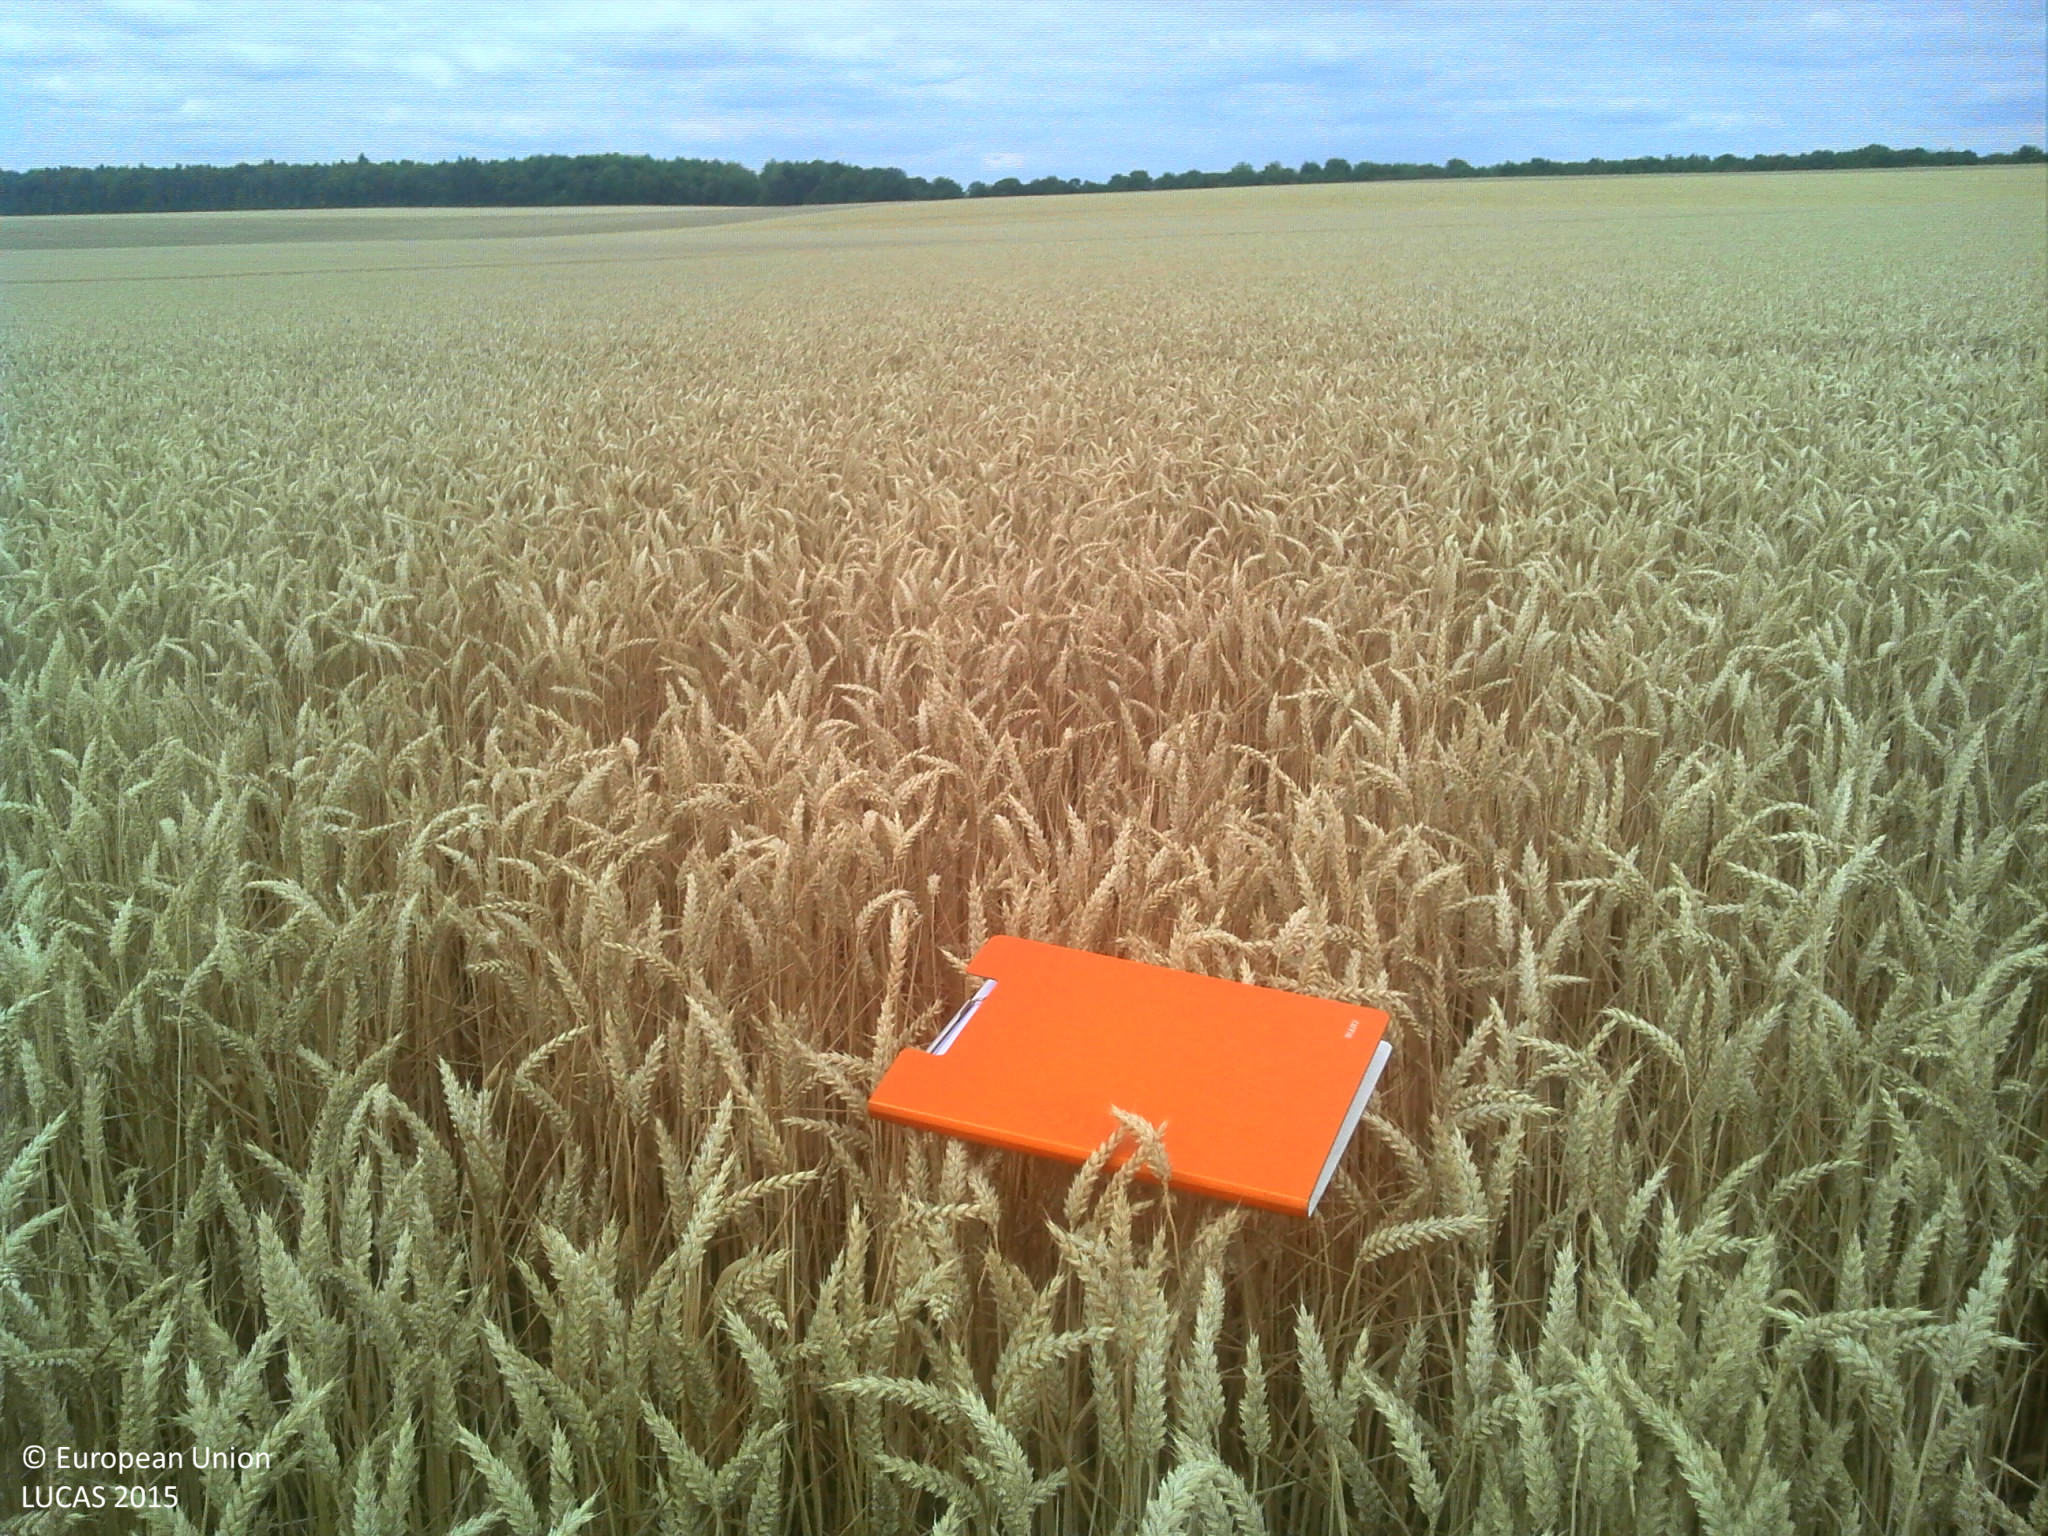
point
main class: Cropland
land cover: Common wheat
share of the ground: > 75 %
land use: Agriculture (excluding fallow land and kitchen gardens)
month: July
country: FR
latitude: 48.1659
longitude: 5.0375
